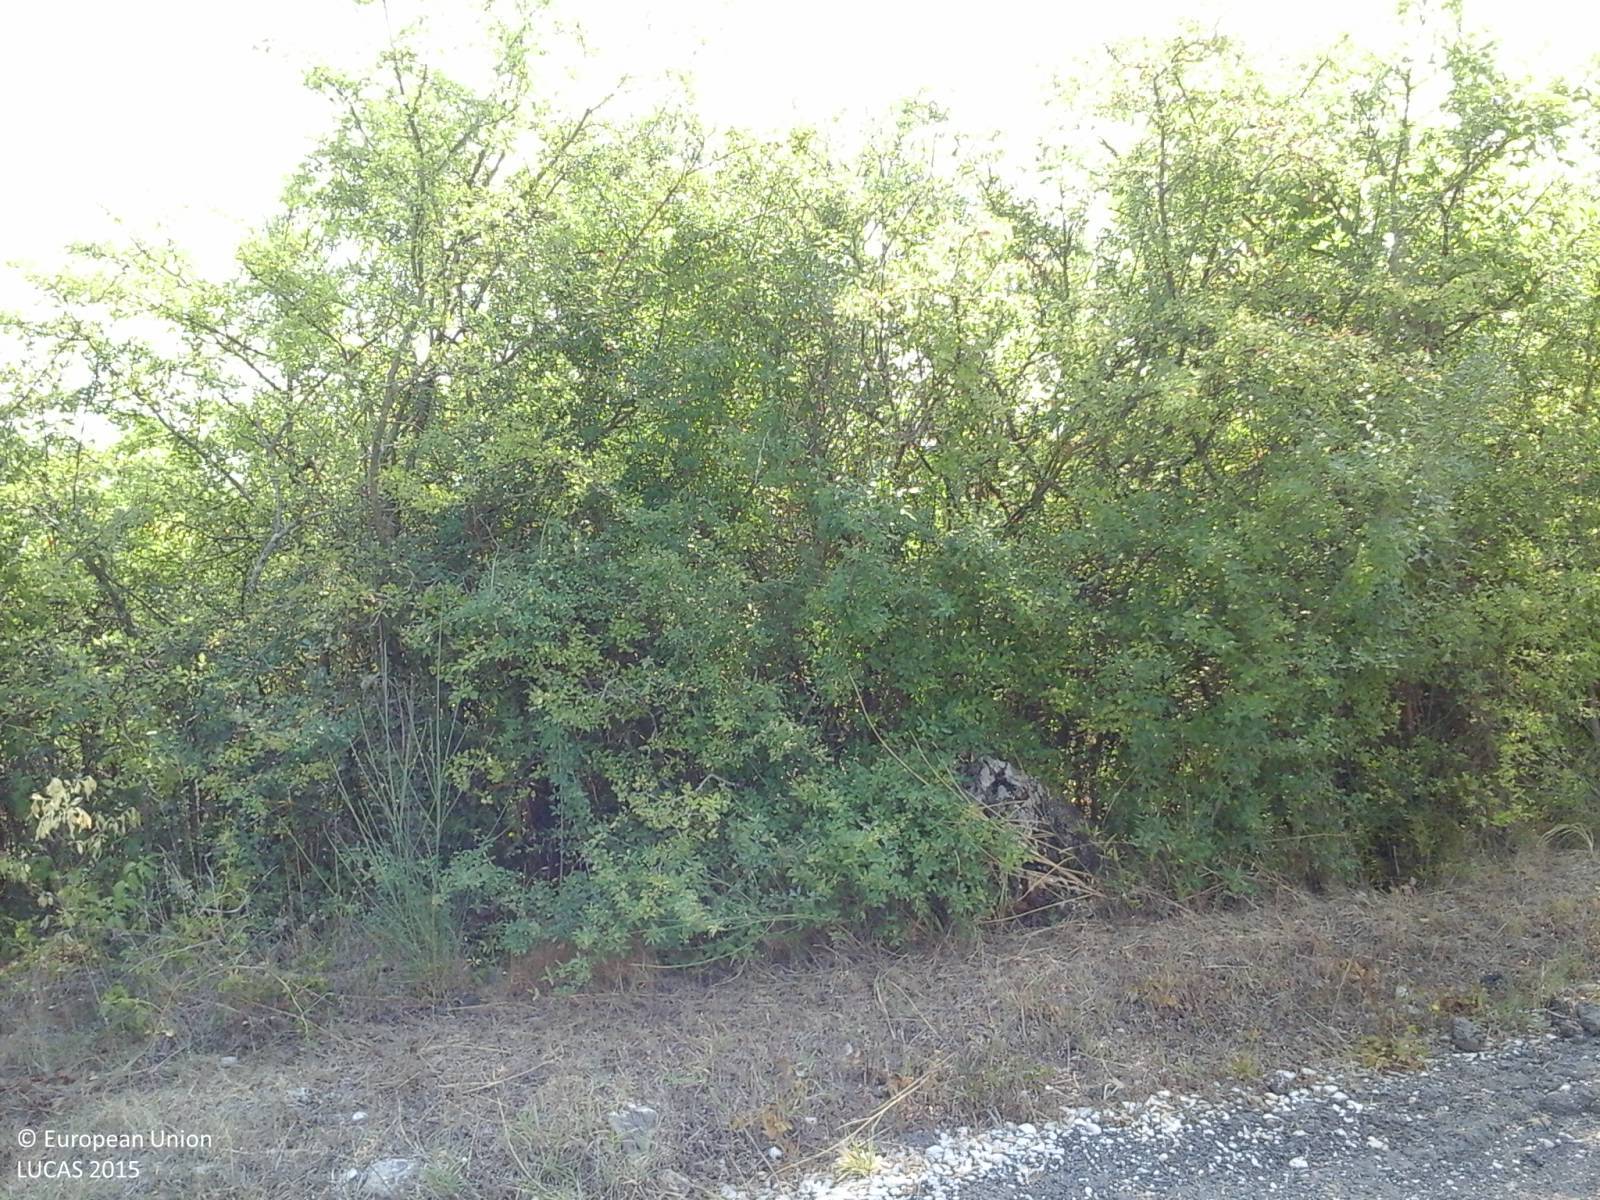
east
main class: Woodland
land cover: Broadleaved woodland
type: thermophilous deciduous forest
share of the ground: > 75 %
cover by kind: broadleaved forest trees 75 %, shrubs 25 %
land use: Forestry
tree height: < 5 m
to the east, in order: Broadleaved woodland; Grass margins; Electric lines; Paved roads, cycling and walking lanes; Electric lines; Fences; Grassland with sparse tree/shrub cover; Broadleaved woodland
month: August
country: IT
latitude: 42.1988
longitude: 12.0877
